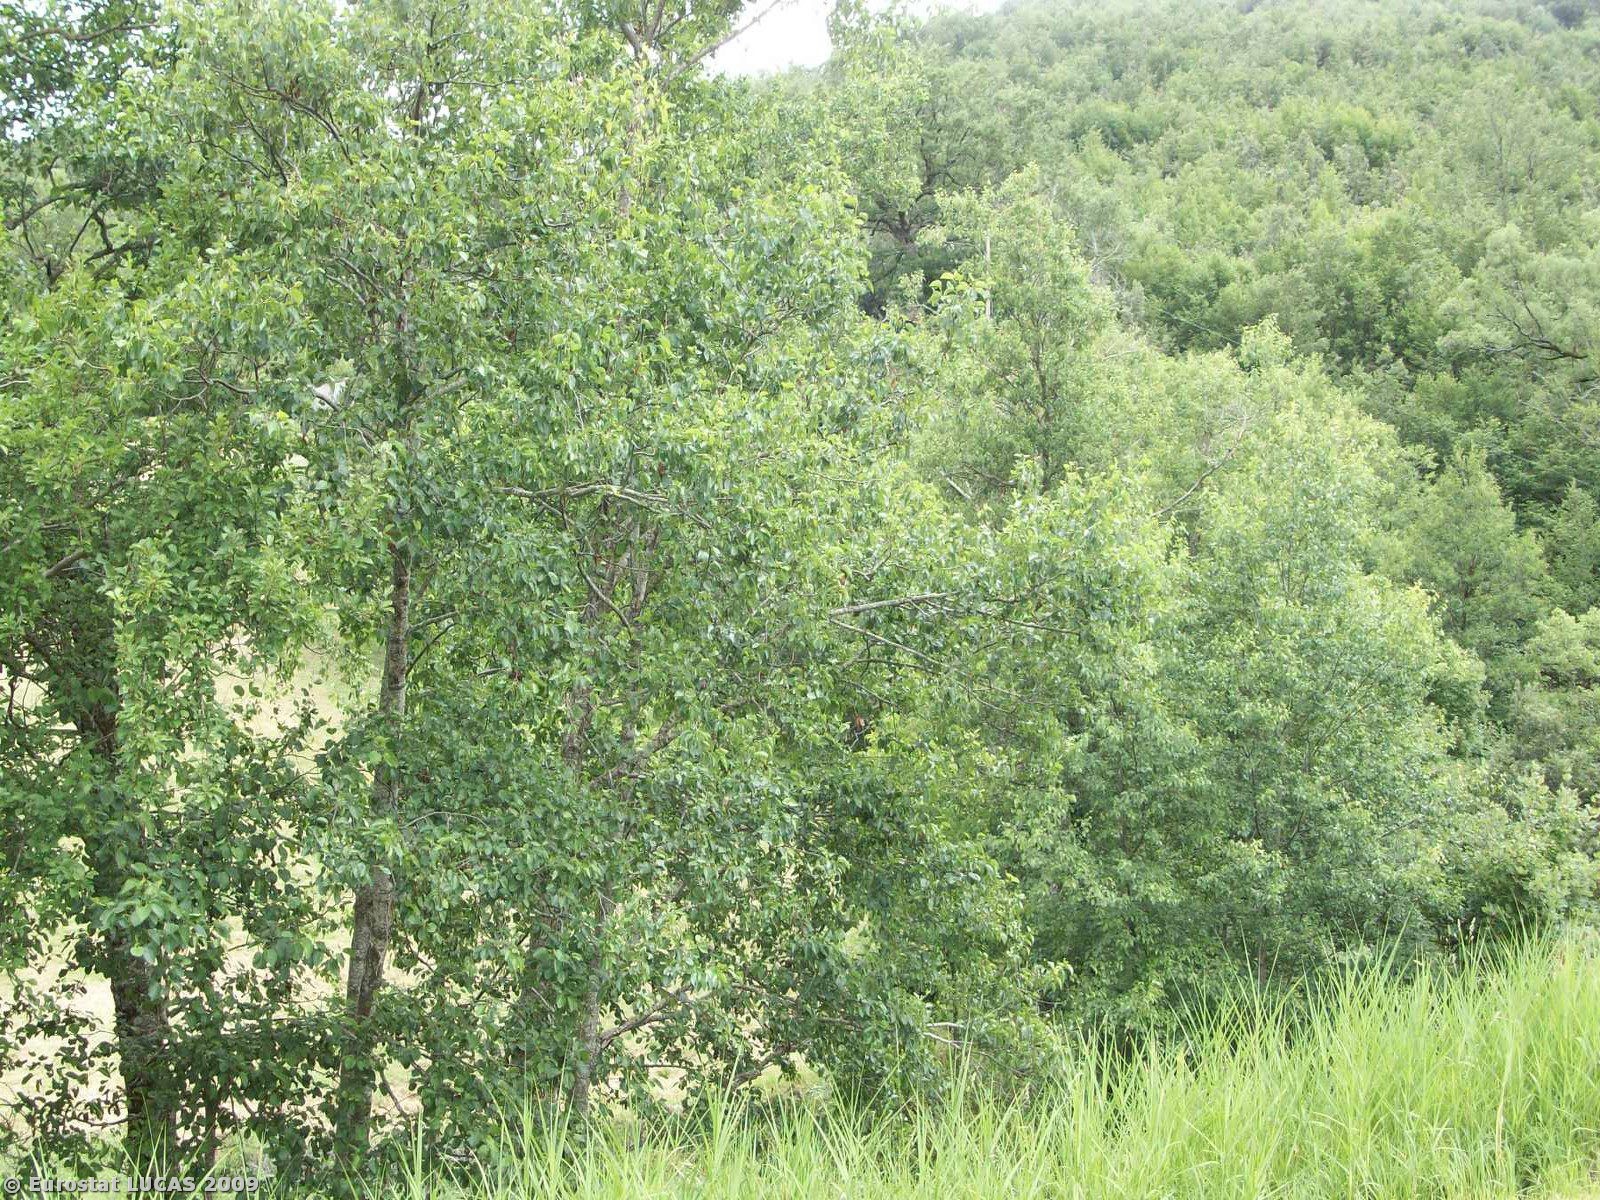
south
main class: Cropland
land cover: Mixed cereals for fodder
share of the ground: > 75 %
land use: Agriculture (excluding fallow land and kitchen gardens)
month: June
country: IT
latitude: 40.0357
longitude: 15.8926
